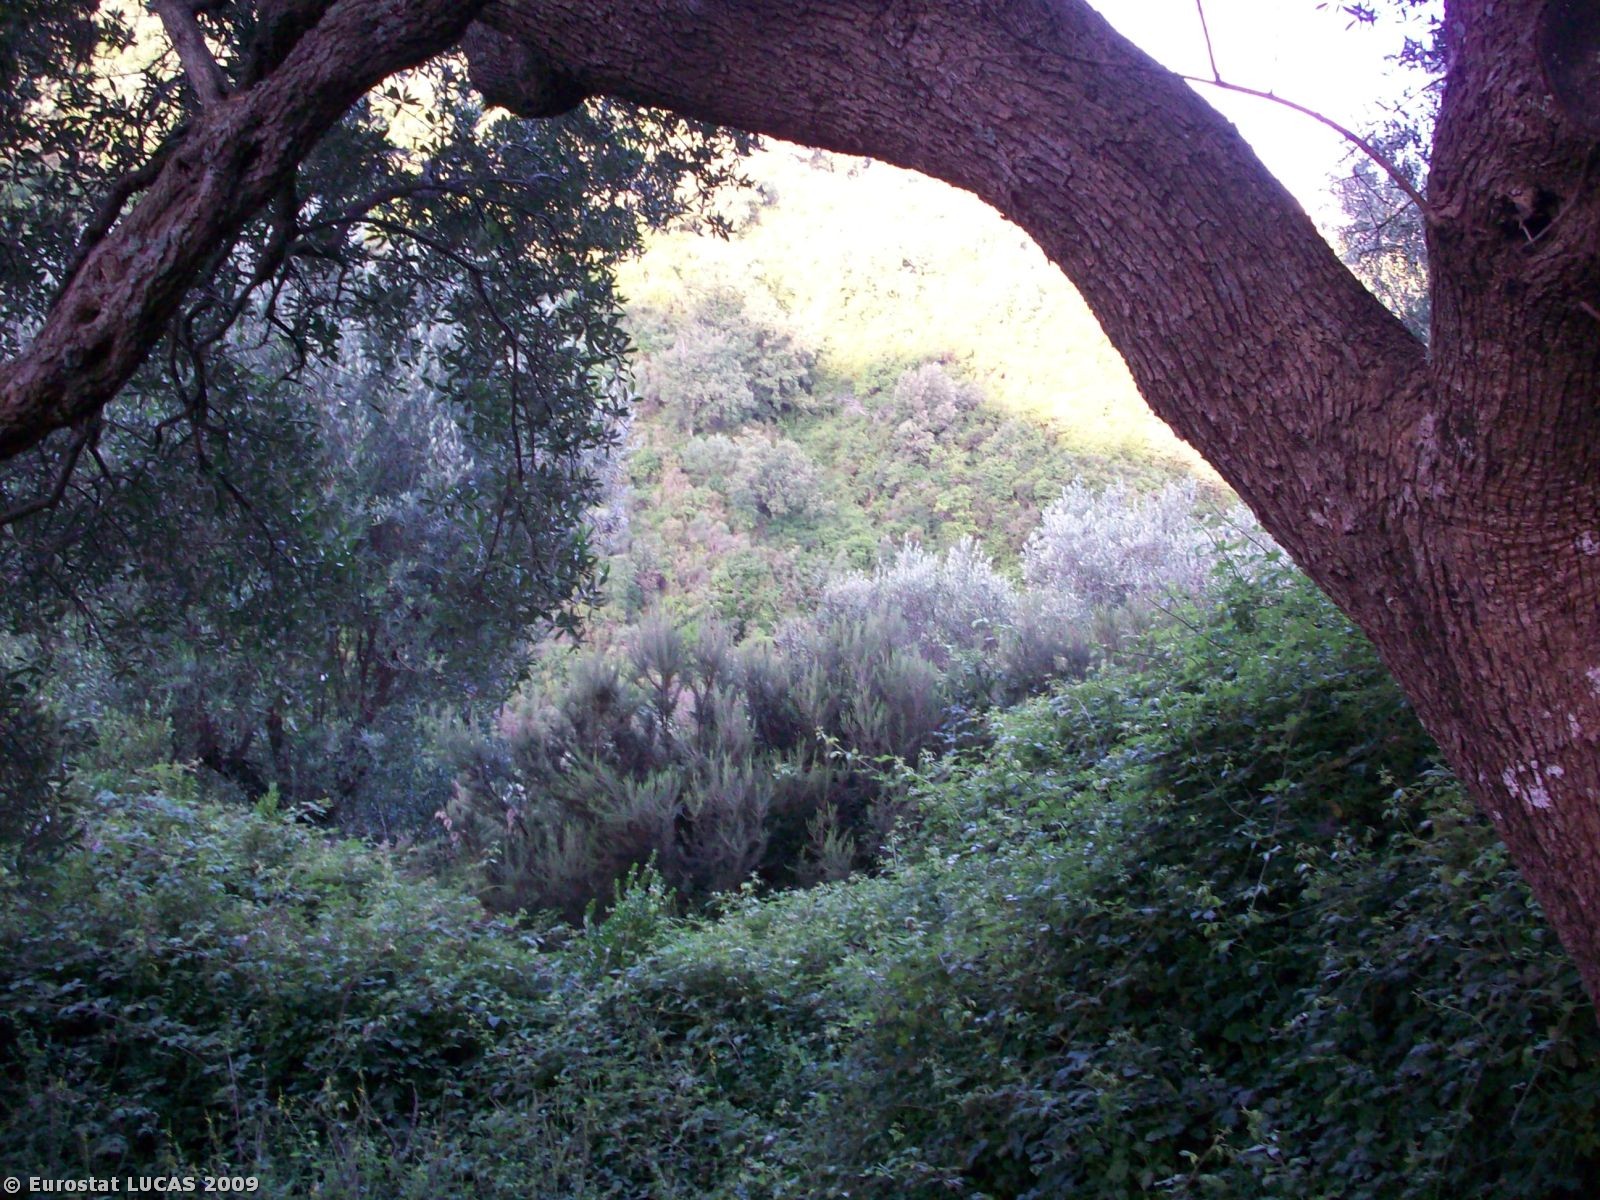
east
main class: Cropland
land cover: Olive groves
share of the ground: 50 - 75 %
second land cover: Spontaneously vegetated surfaces
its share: > 75 %
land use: Agriculture (excluding fallow land and kitchen gardens)
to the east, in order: Olive groves; Spontaneously vegetated surfaces; Shrubland with sparse tree cover; Broadleaved woodland; Ditches and canals; Broadleaved woodland
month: July
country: IT
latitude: 40.0935
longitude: 15.5235
